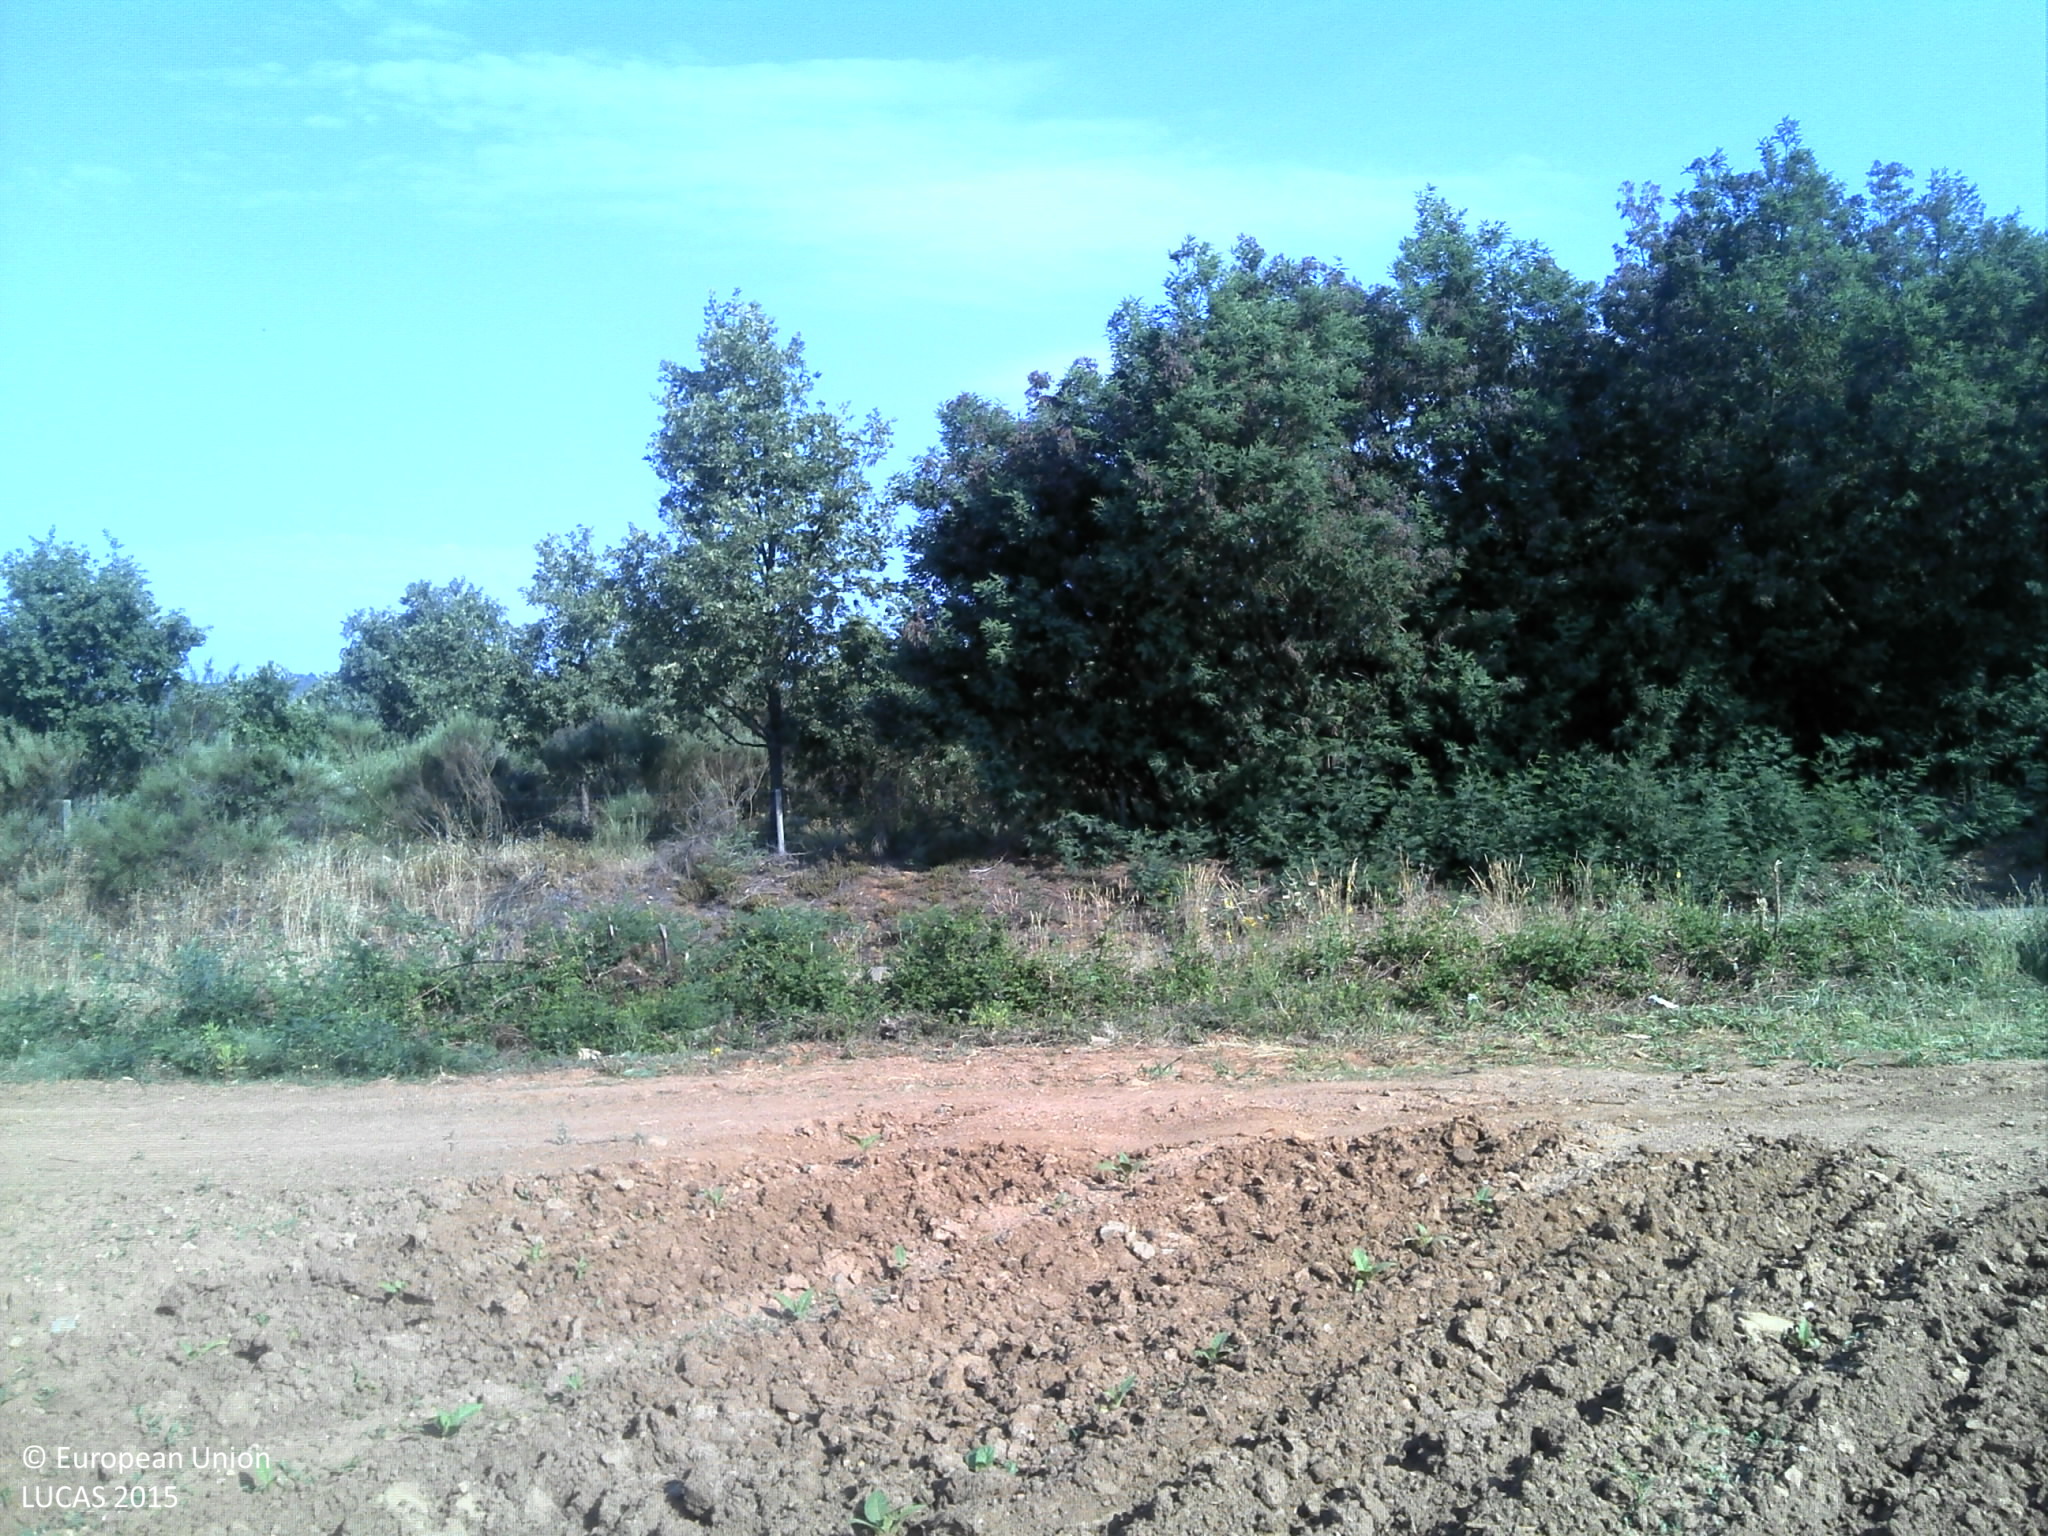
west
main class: Cropland
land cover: Tobacco
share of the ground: < 10 %
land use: Agriculture (excluding fallow land and kitchen gardens)
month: June
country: PT
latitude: 40.2051
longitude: -7.3369
